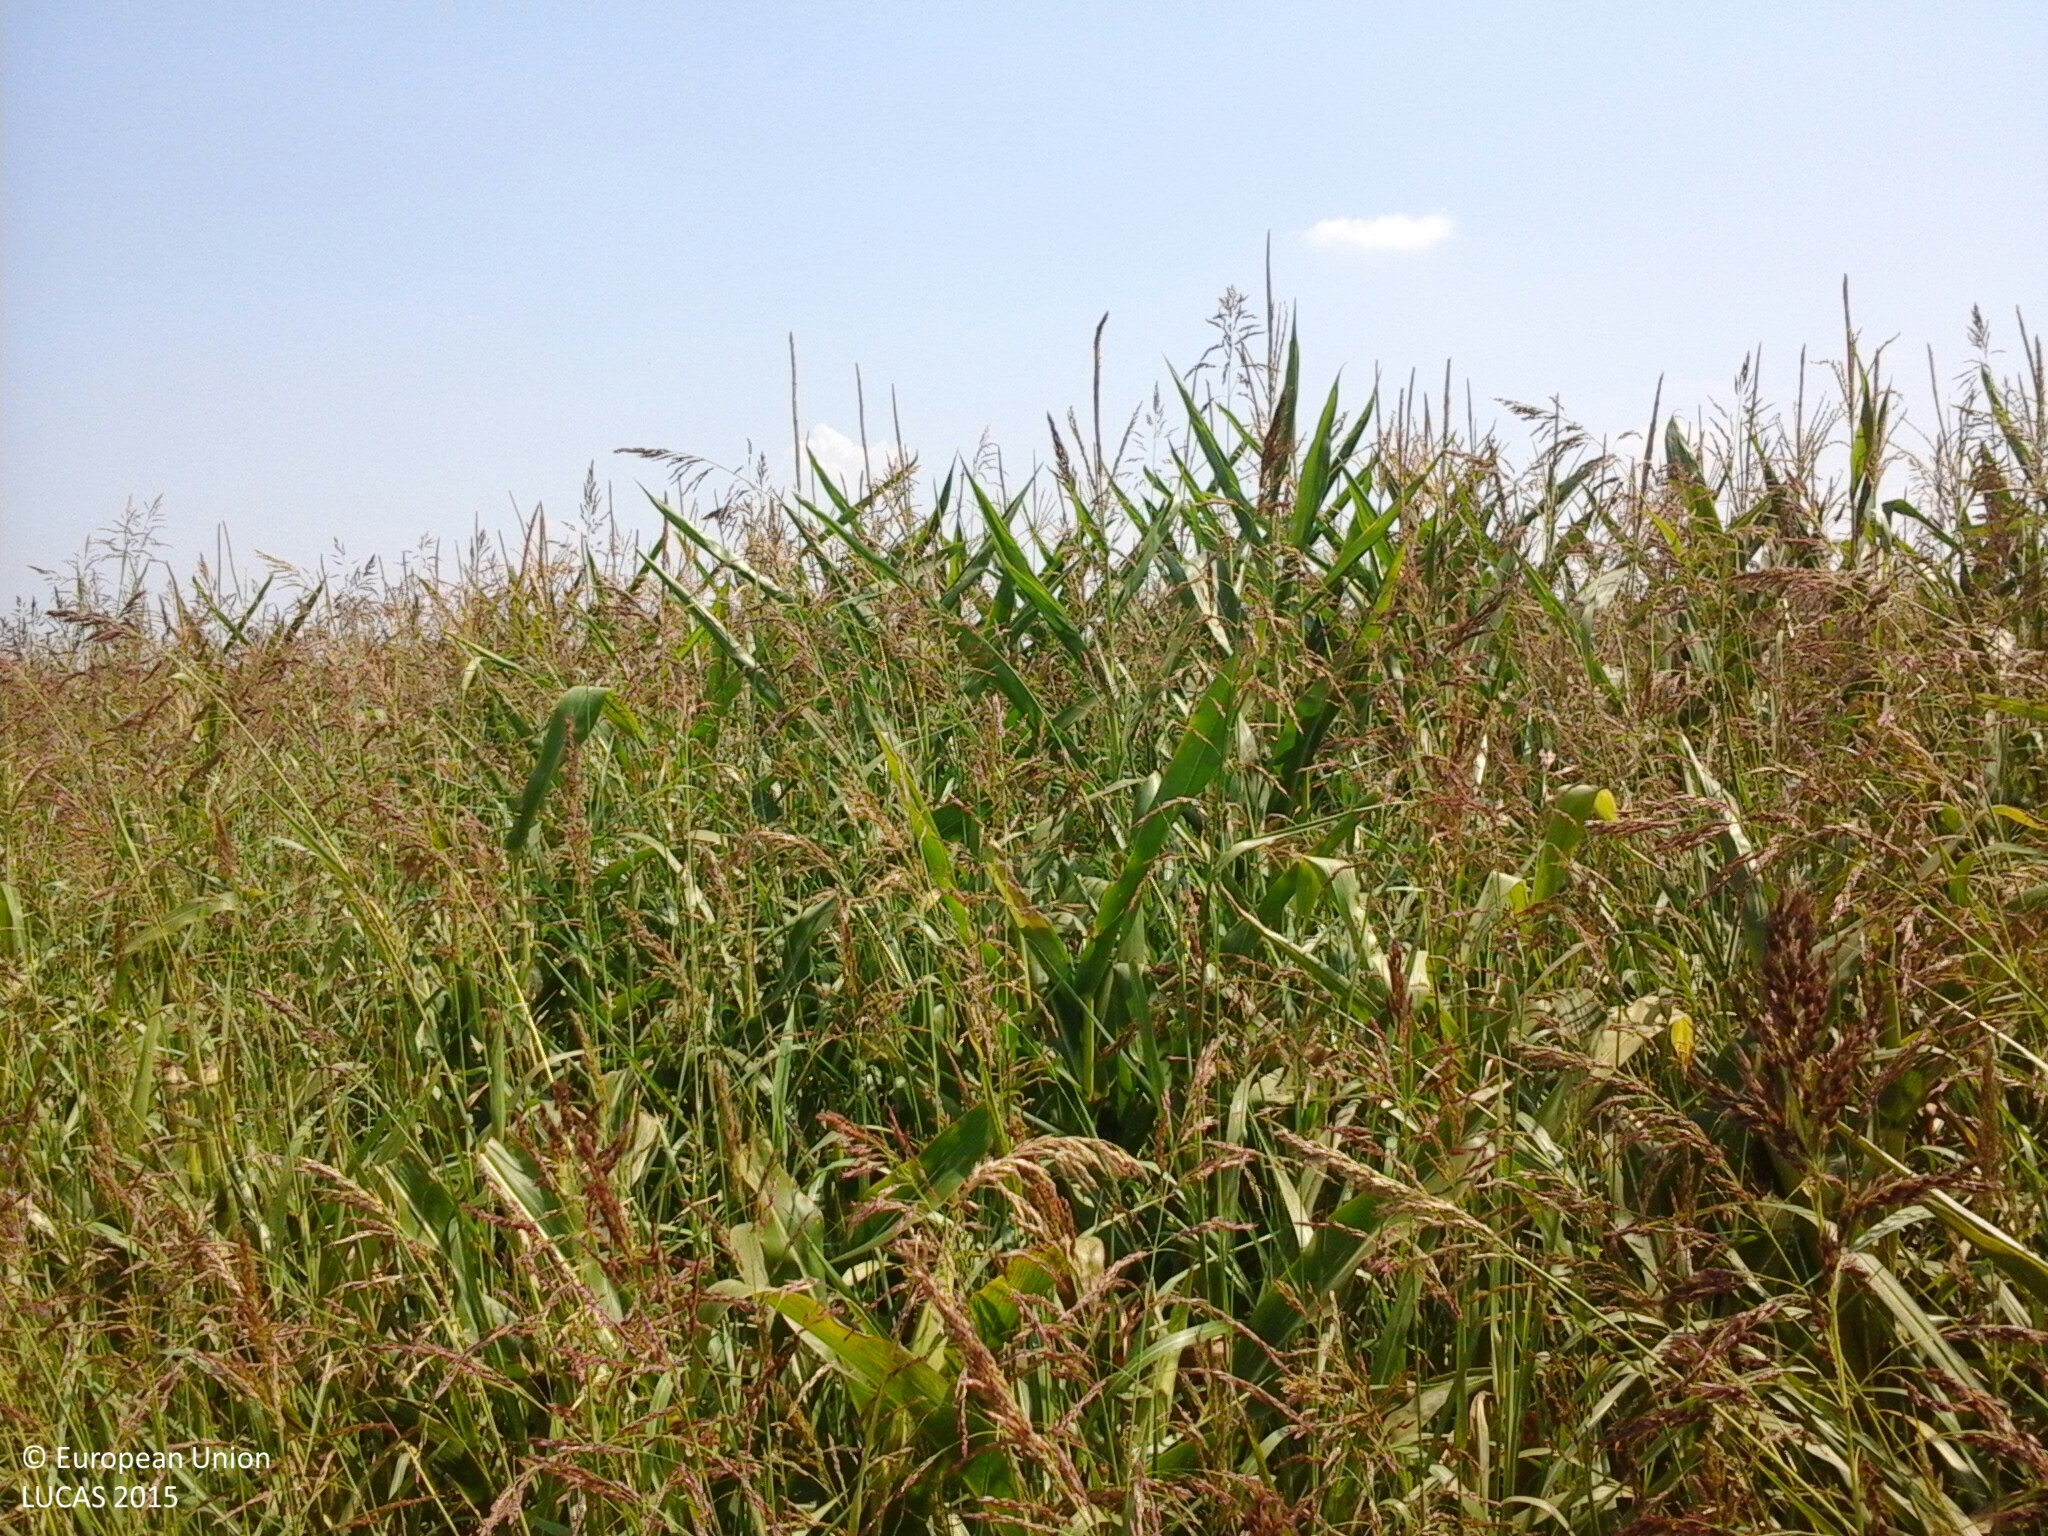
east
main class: Cropland
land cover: Maize
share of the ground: > 75 %
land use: Agriculture (excluding fallow land and kitchen gardens)
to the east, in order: Maize
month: August
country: HU
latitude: 46.8894
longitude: 18.3974
